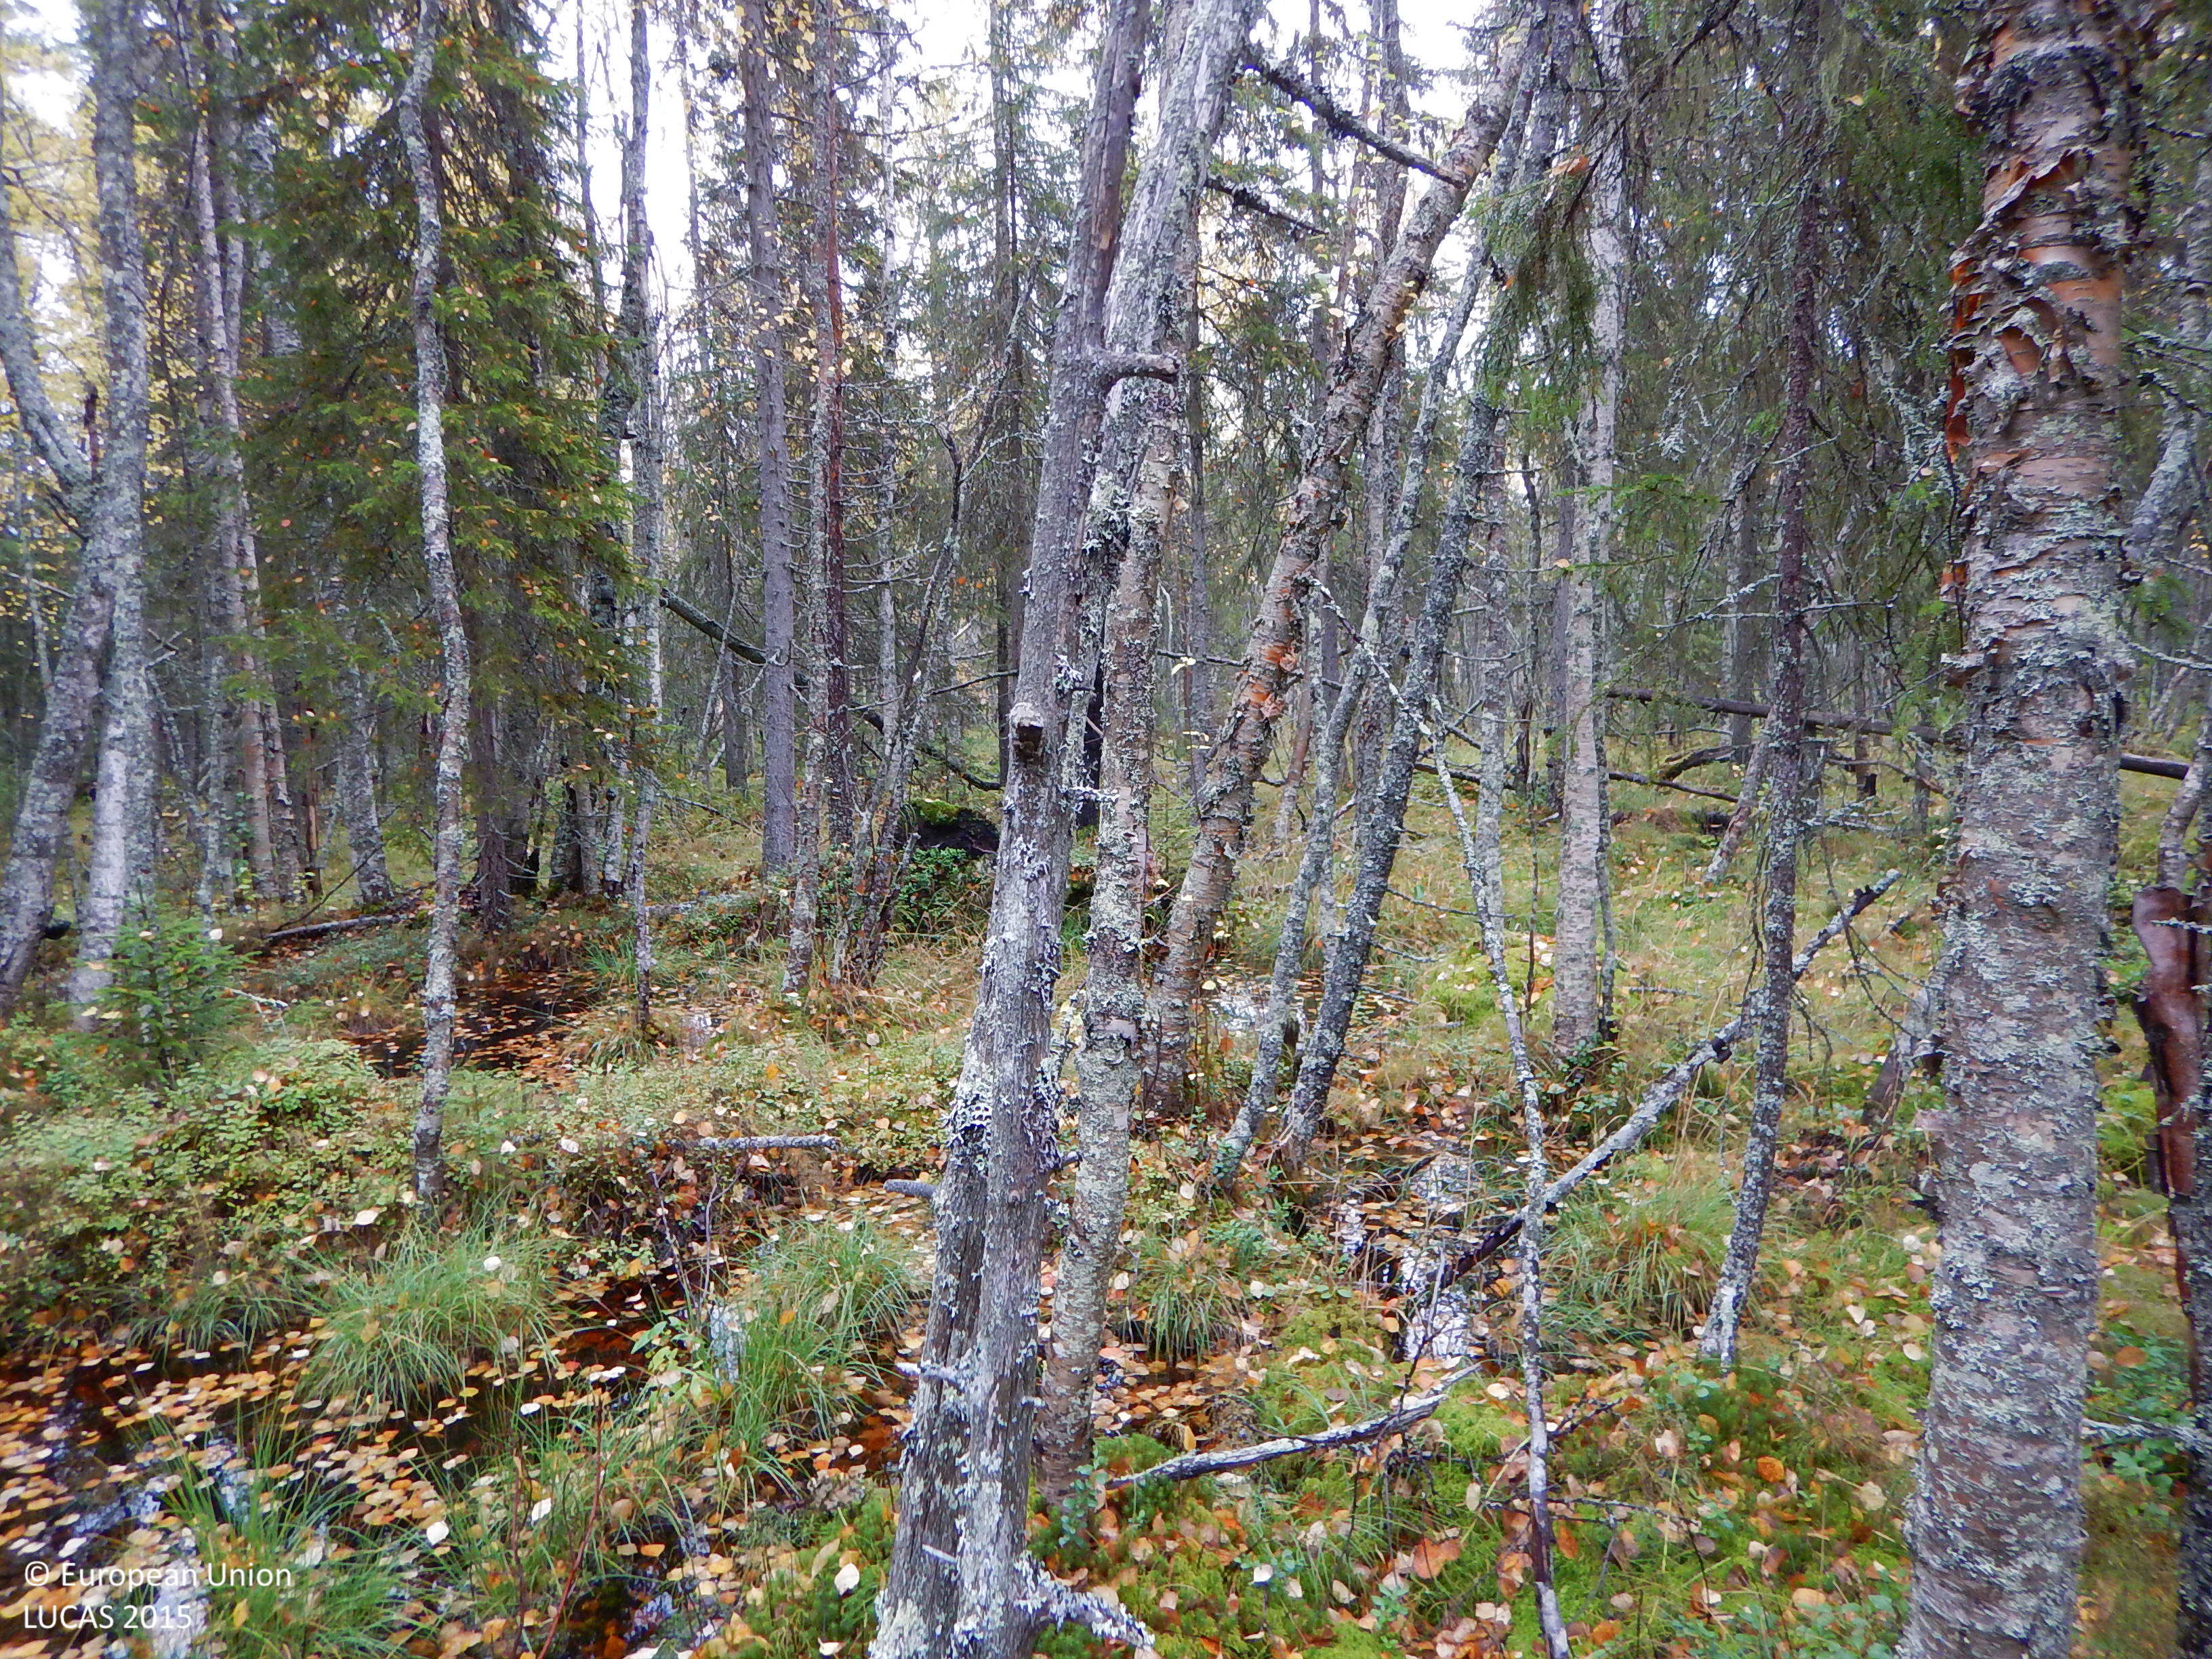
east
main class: Woodland
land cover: Other mixed woodland
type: mire and swamp forests
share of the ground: 50 - 75 %
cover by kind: coniferous forest trees 30 %, broadleaved forest trees 30 %, lichens and mosses 20 %, shrubs 10 %, herbaceous plants 10 %
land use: Amenities, museums, leisure
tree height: > 5 m
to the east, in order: Other mixed woodland; Peatbogs; Pine dominated coniferous woodland
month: September
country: SE
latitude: 65.0881
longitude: 19.9470
